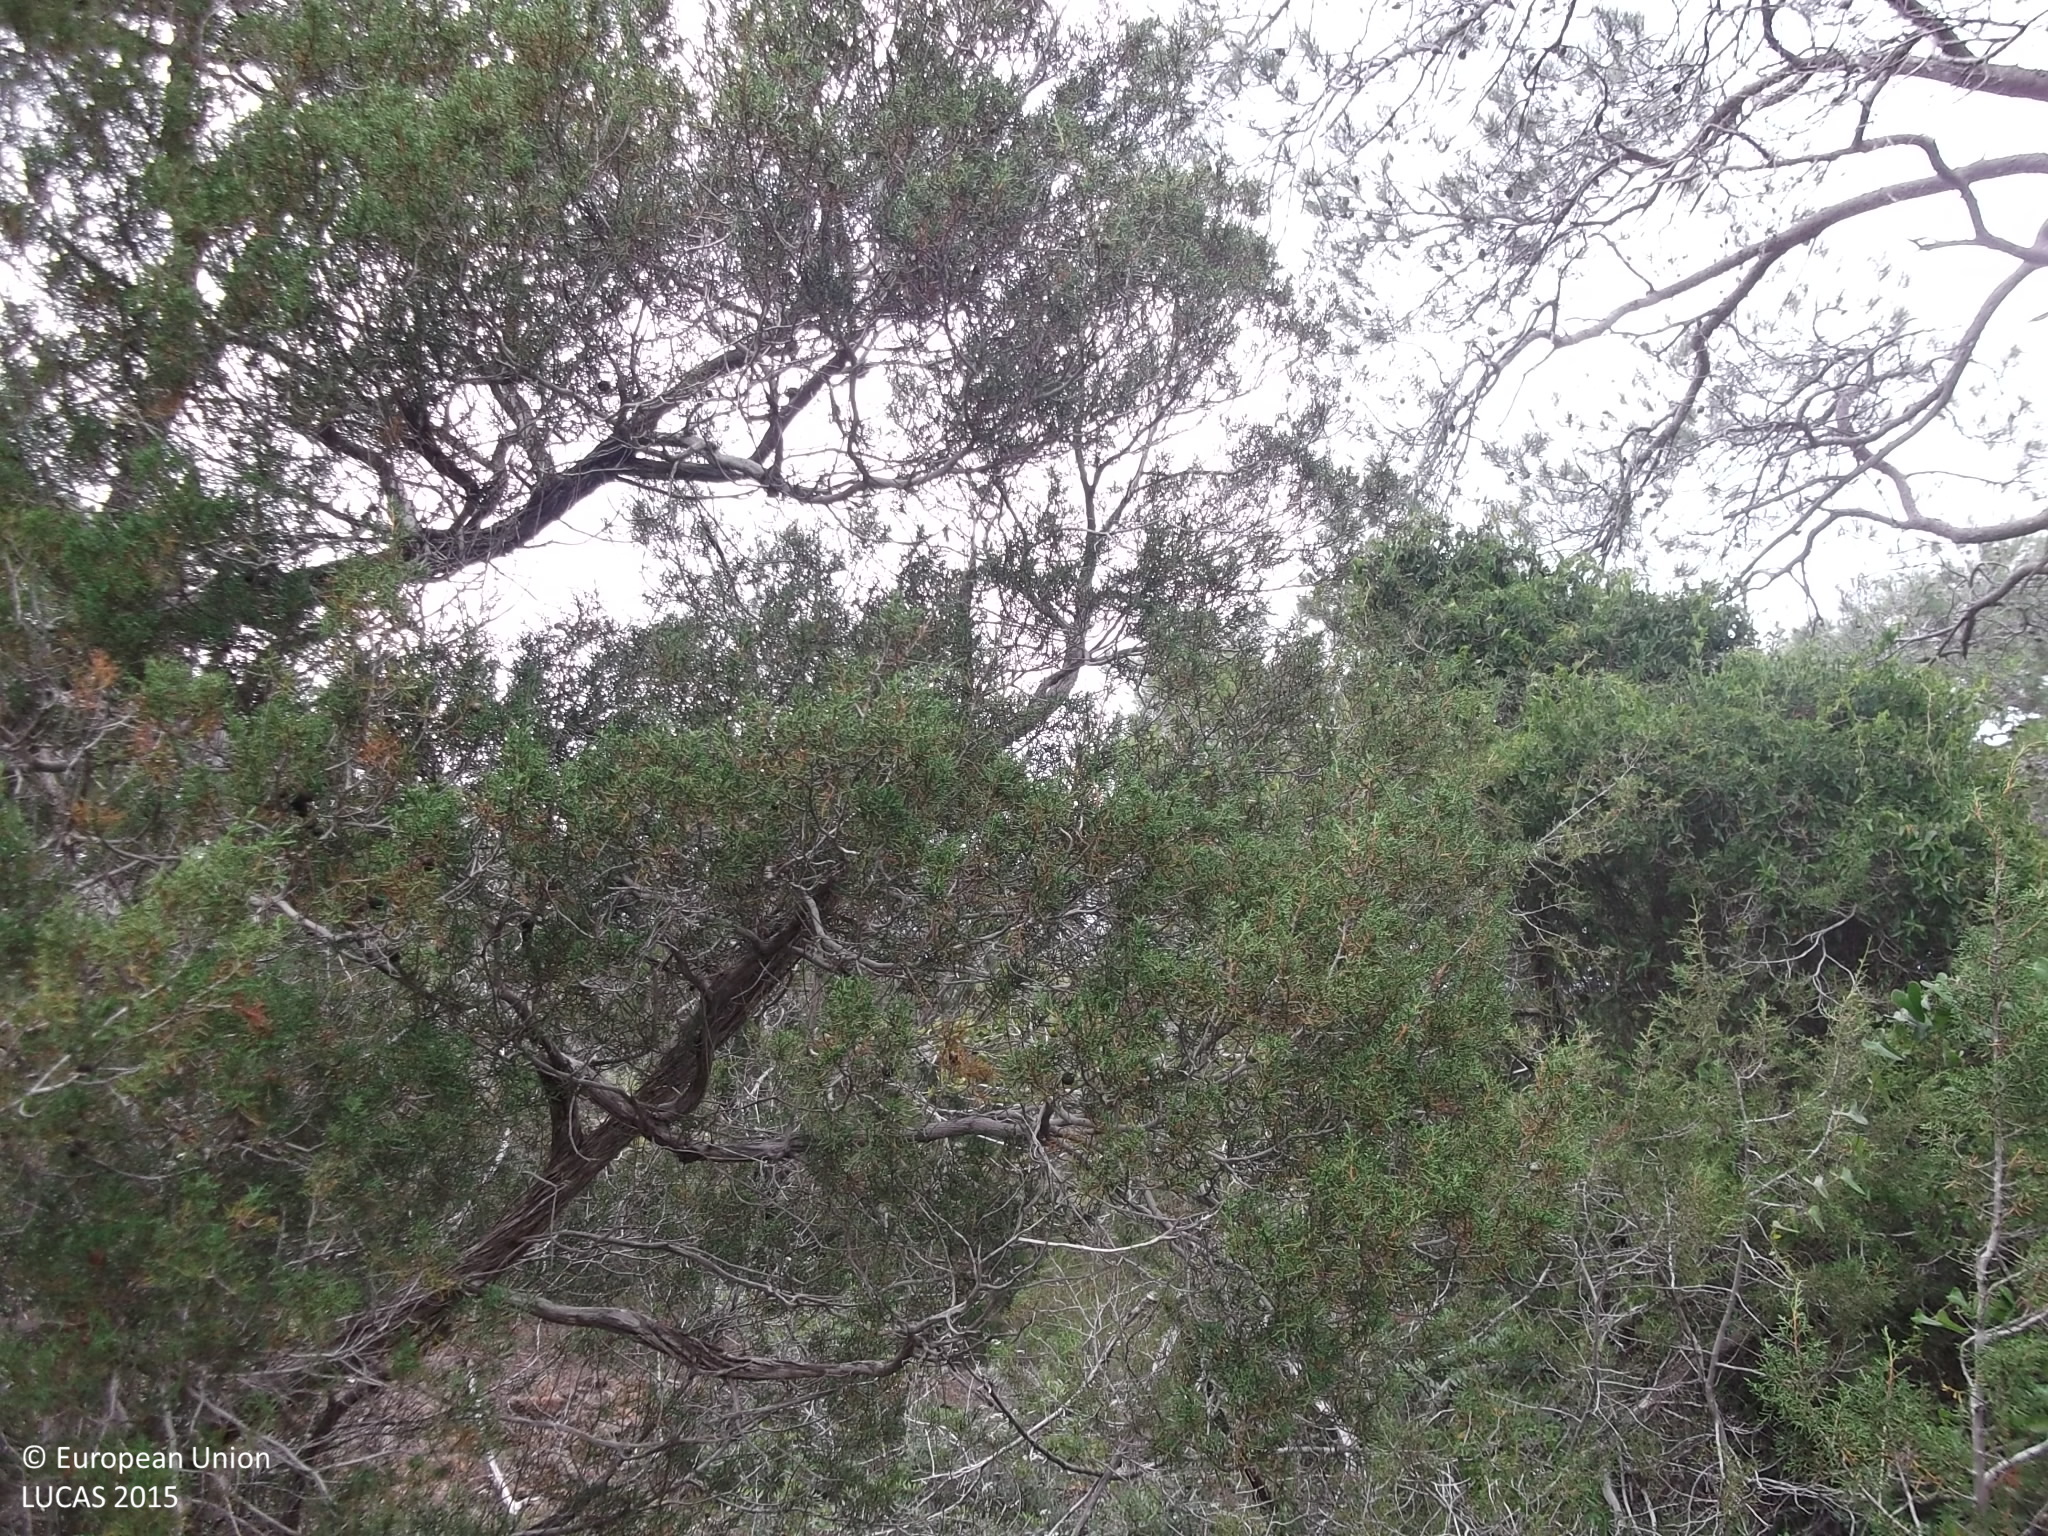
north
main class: Woodland
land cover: Other coniferous woodland
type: coniferous forest of the mediterranean region
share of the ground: > 75 %
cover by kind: coniferous forest trees 80 %, shrubs 10 %, unconsolidated bare surface 10 %
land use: Forestry
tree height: > 5 m
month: May
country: CY
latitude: 35.0385
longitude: 32.3257
